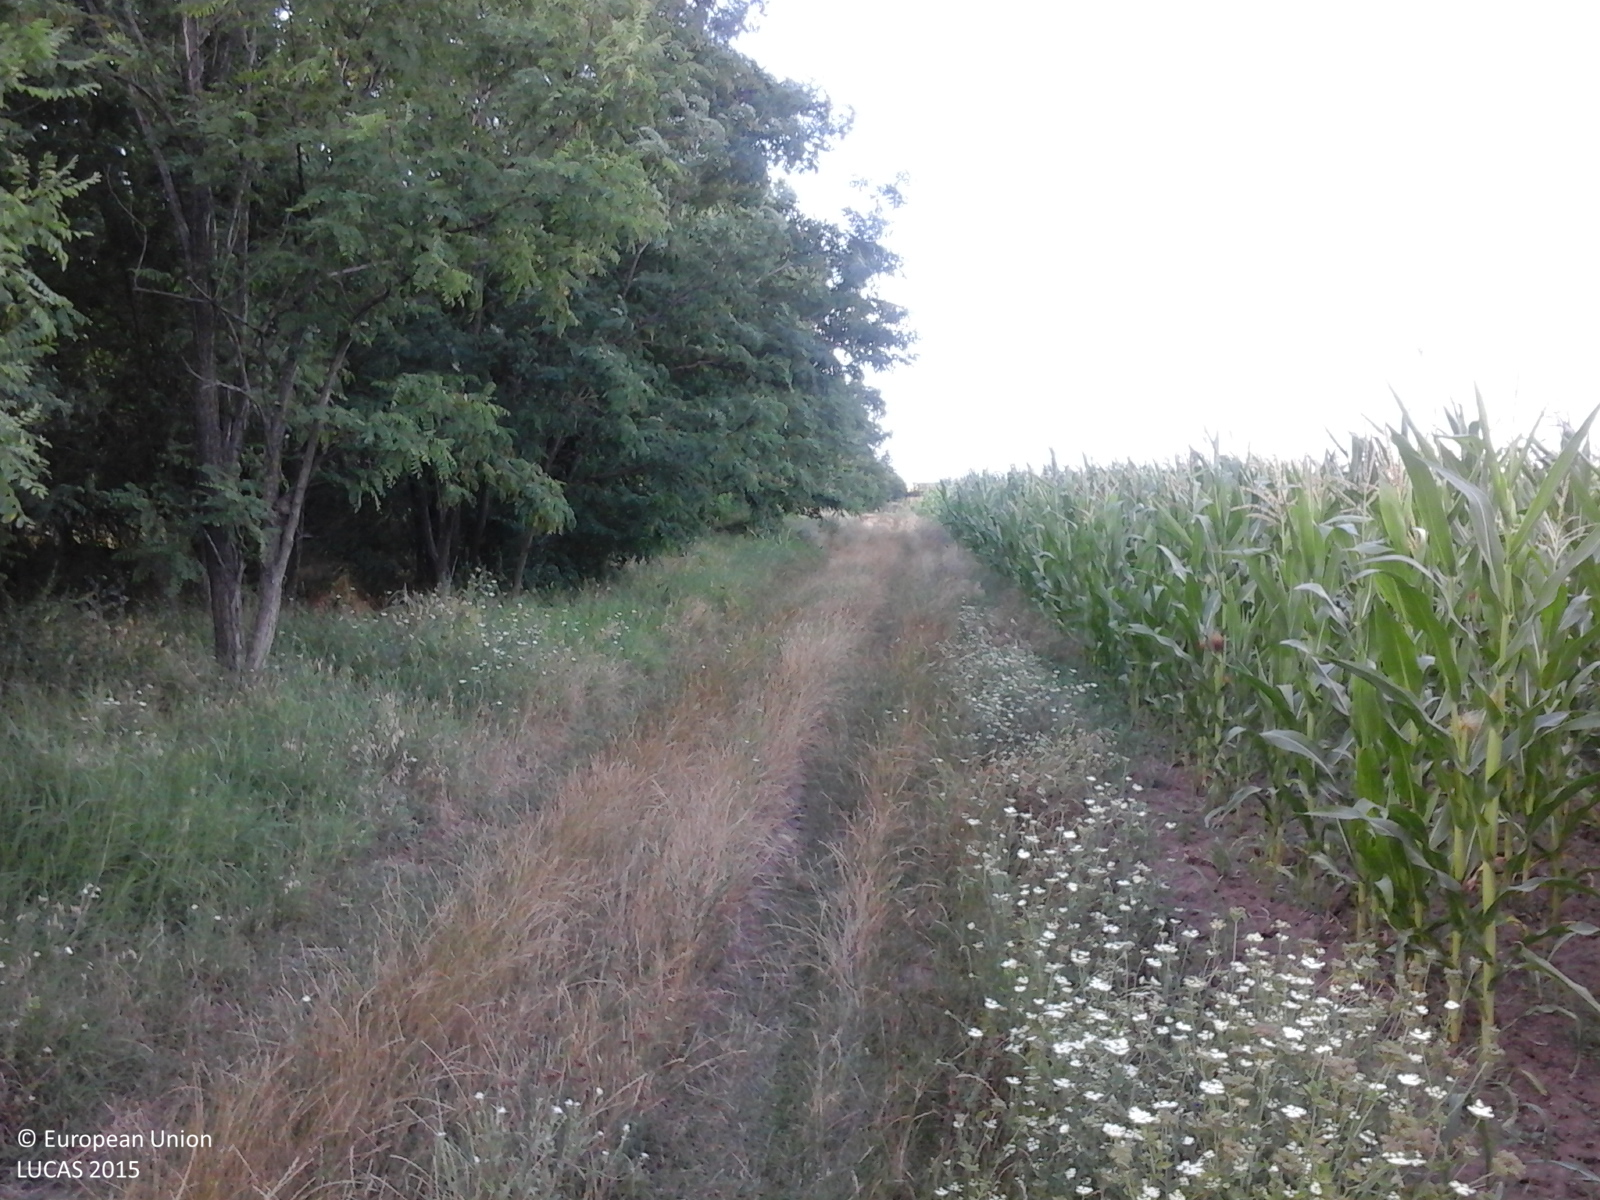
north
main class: Cropland
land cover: Maize
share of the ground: > 75 %
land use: Agriculture (excluding fallow land and kitchen gardens)
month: July
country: RO
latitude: 43.7660
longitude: 24.2331
